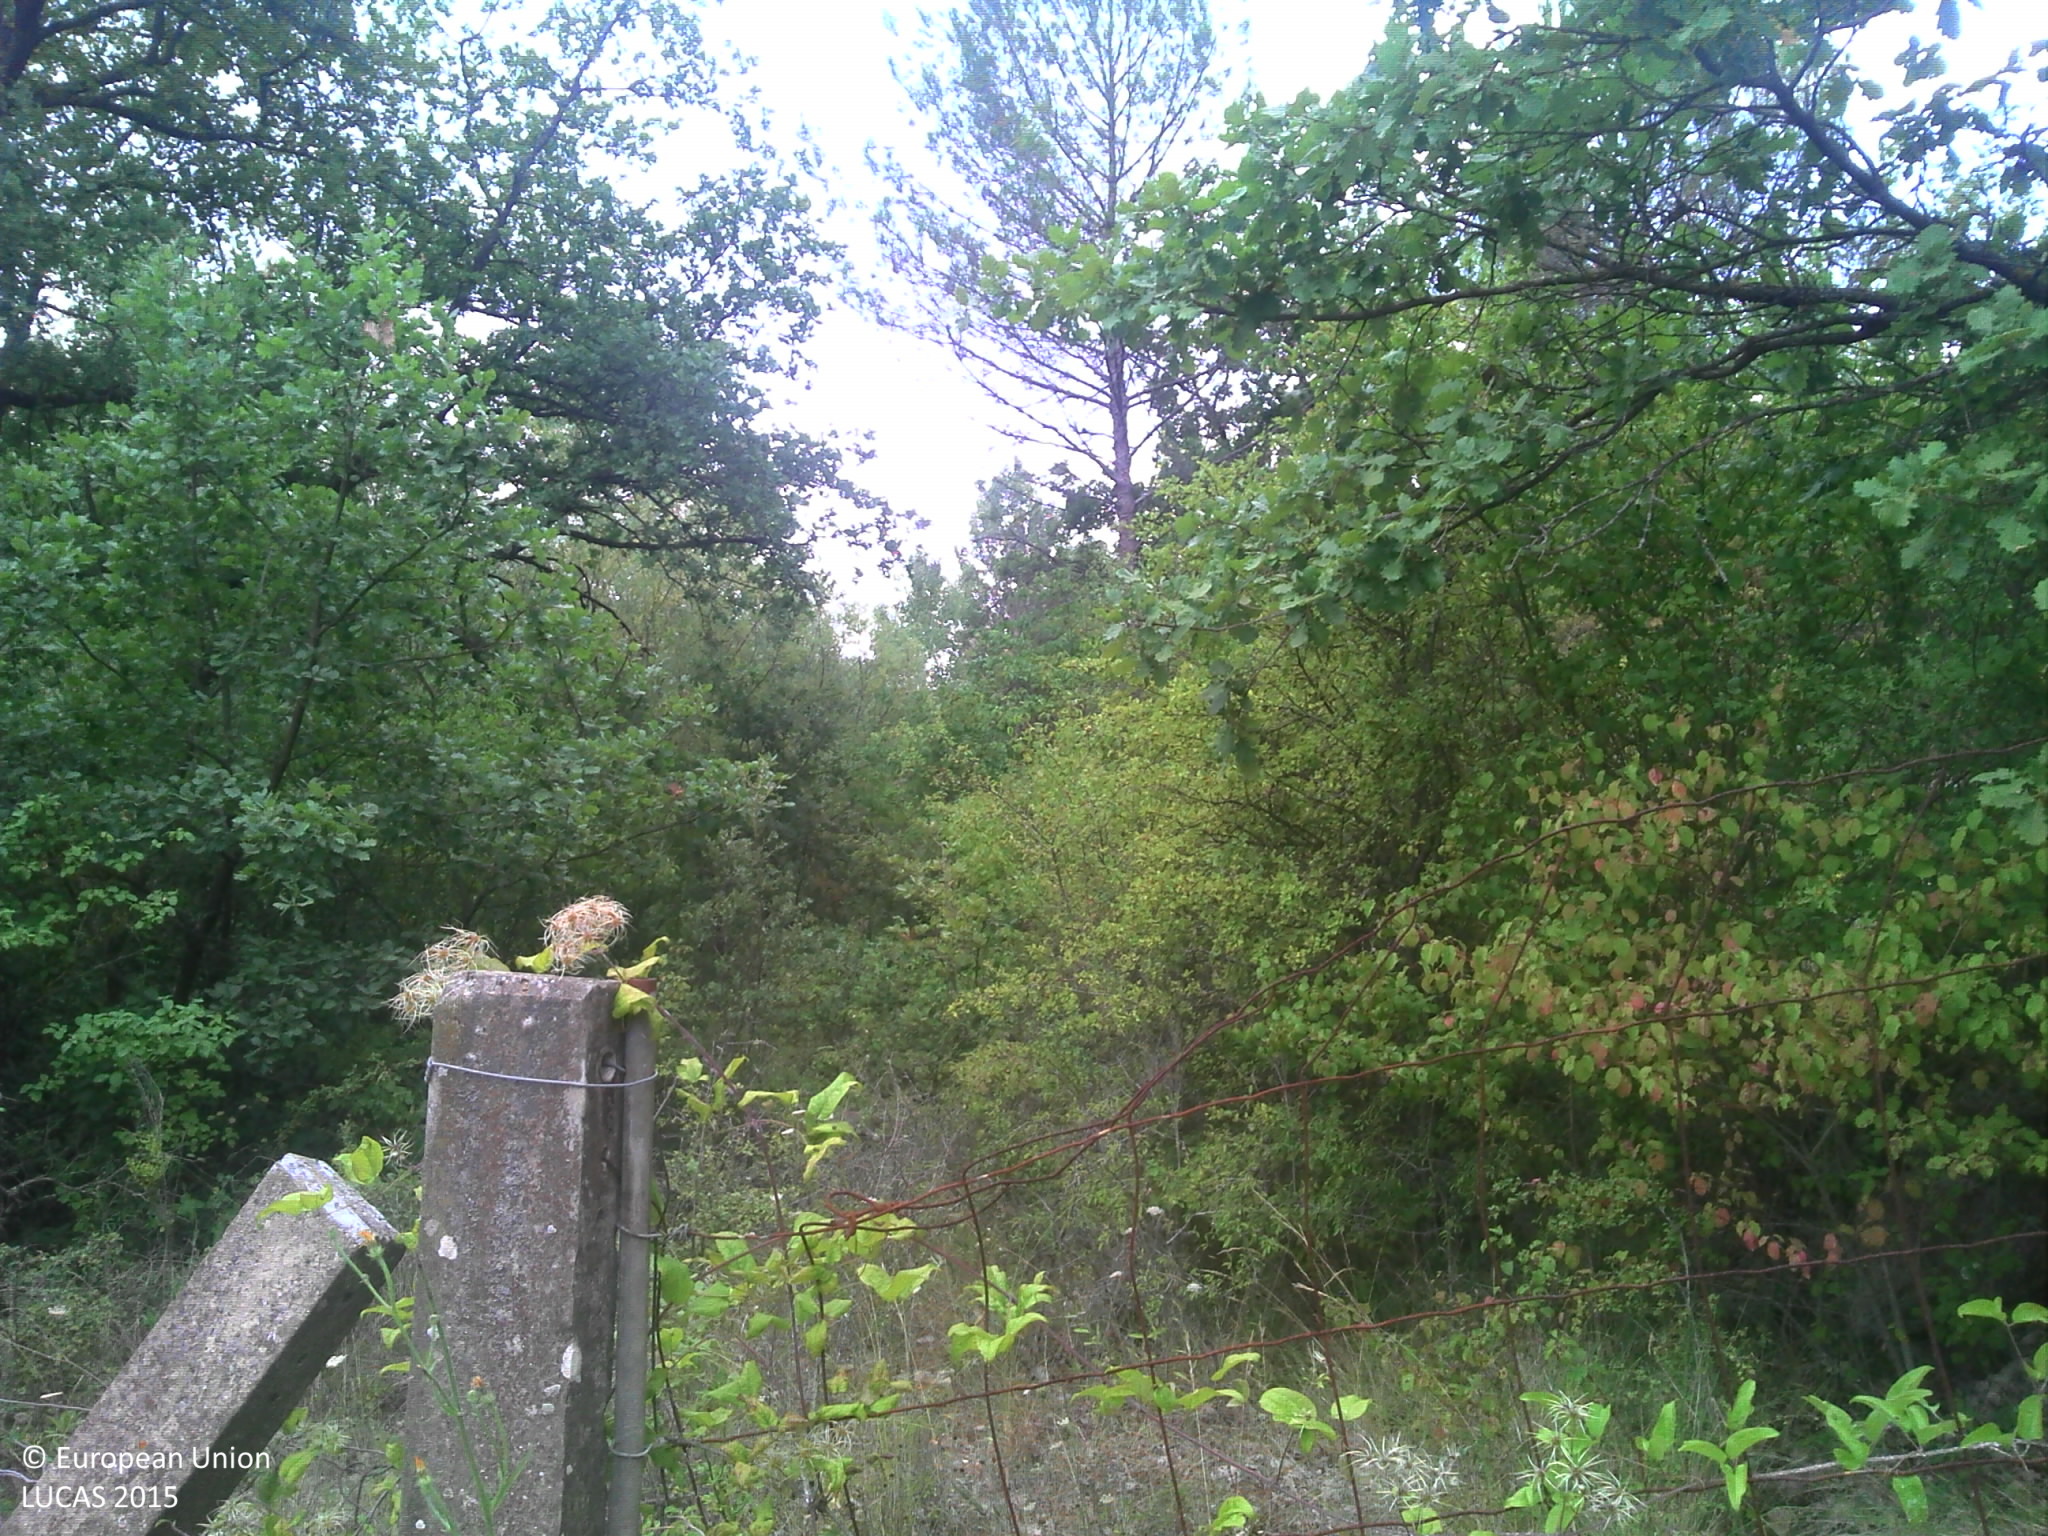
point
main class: Woodland
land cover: Pine dominated mixed woodland
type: coniferous forest of the mediterranean region
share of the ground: > 75 %
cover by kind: coniferous forest trees 45 %, broadleaved forest trees 30 %, shrubs 25 %
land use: Sport
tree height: < 5 m
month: August
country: FR
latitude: 43.4251
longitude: 5.5754
